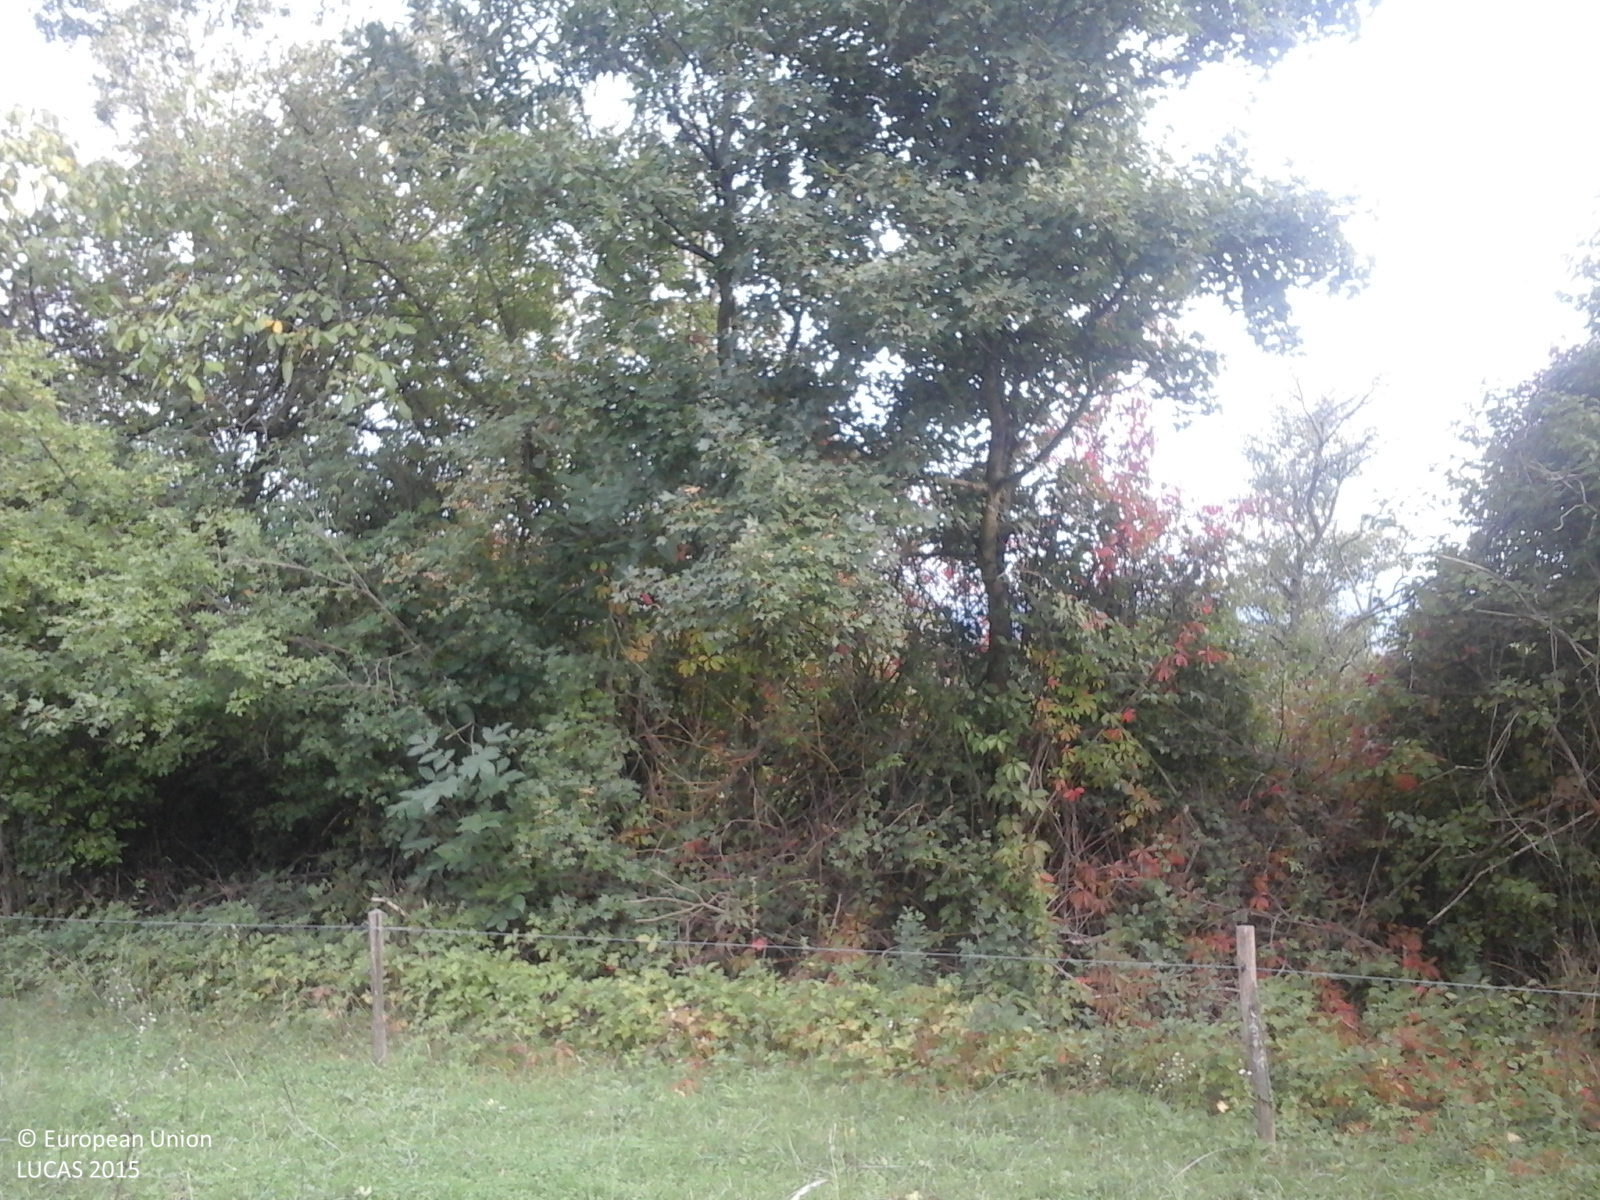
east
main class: Grassland
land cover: Grassland without tree/shrub cover
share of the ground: > 75 %
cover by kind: herbaceous plants 100 %
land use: Agriculture (excluding fallow land and kitchen gardens)
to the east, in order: Grassland without tree/shrub cover; Abandoned hedges; Shrubland with sparse tree cover; Fences; Other fruit trees and berries; Grassland without tree/shrub cover
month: September
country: RO
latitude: 45.9157
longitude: 23.1704
